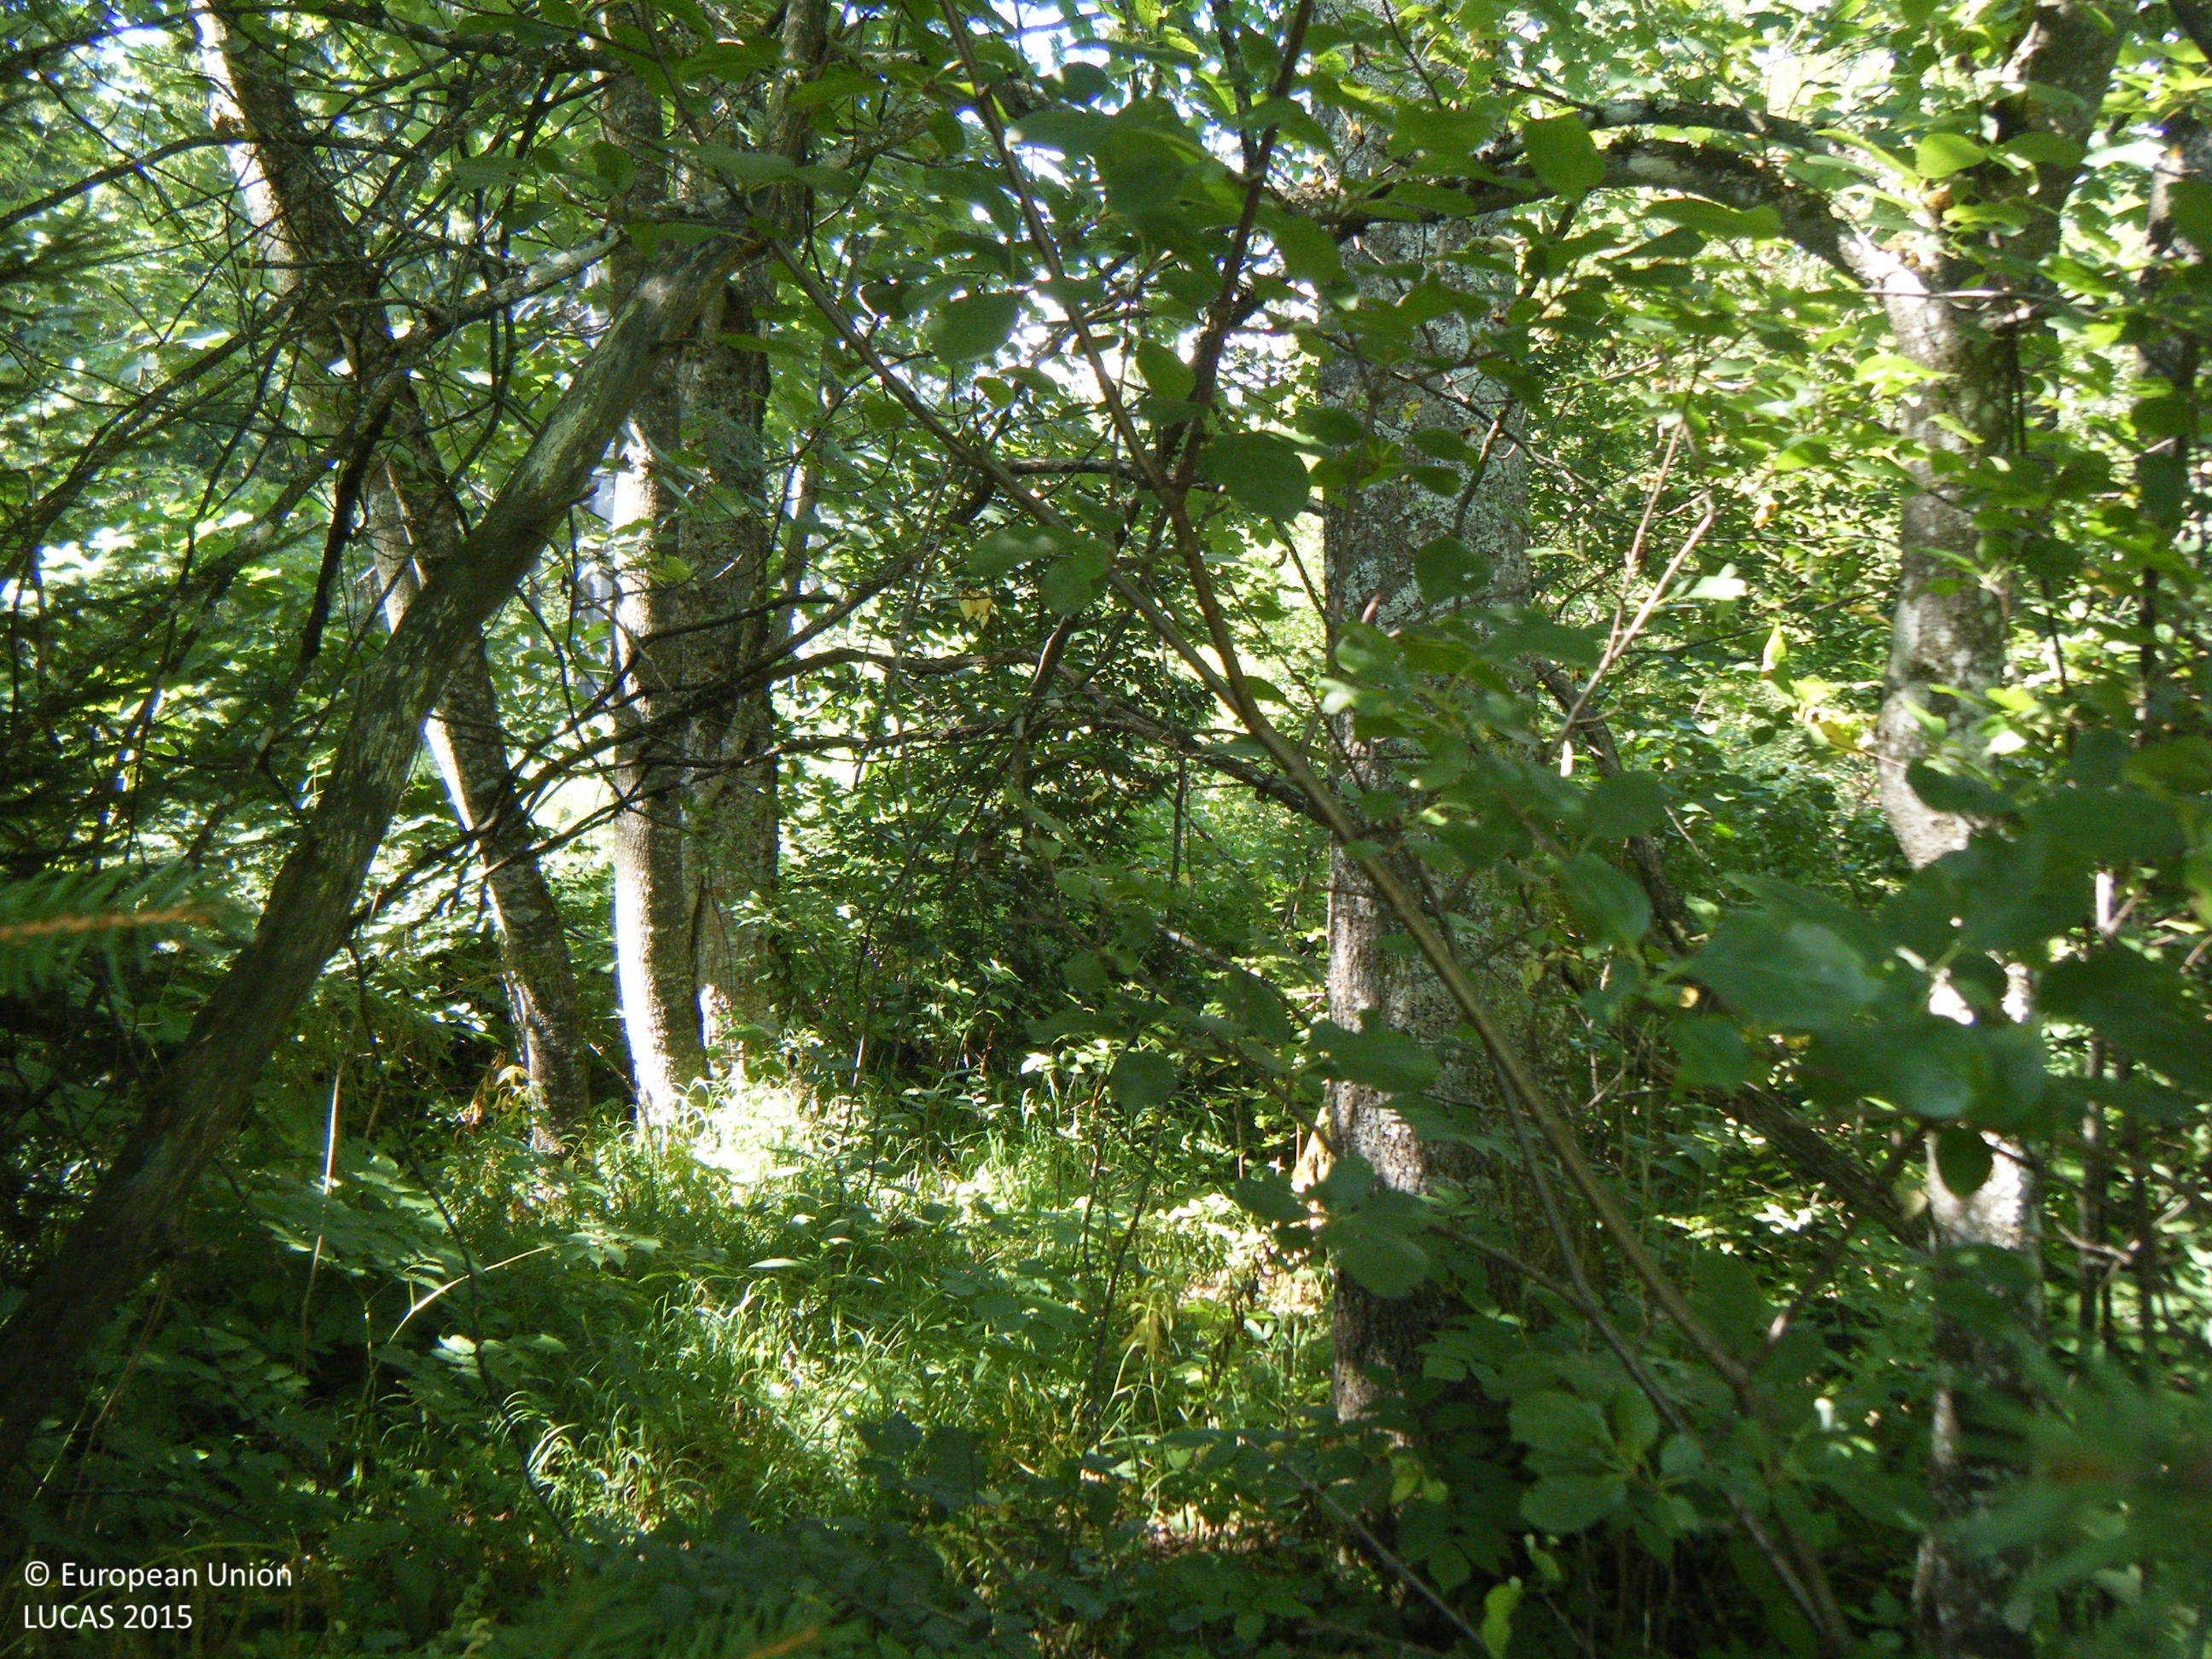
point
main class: Woodland
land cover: Broadleaved woodland
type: floodplain forest
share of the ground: > 75 %
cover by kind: broadleaved forest trees 70 %, coniferous forest trees 20 %, shrubs 5 %, herbaceous plants 5 %
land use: Forestry
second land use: Amenities, museums, leisure
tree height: > 5 m
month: August
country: AT
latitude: 47.5365
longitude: 14.0505
